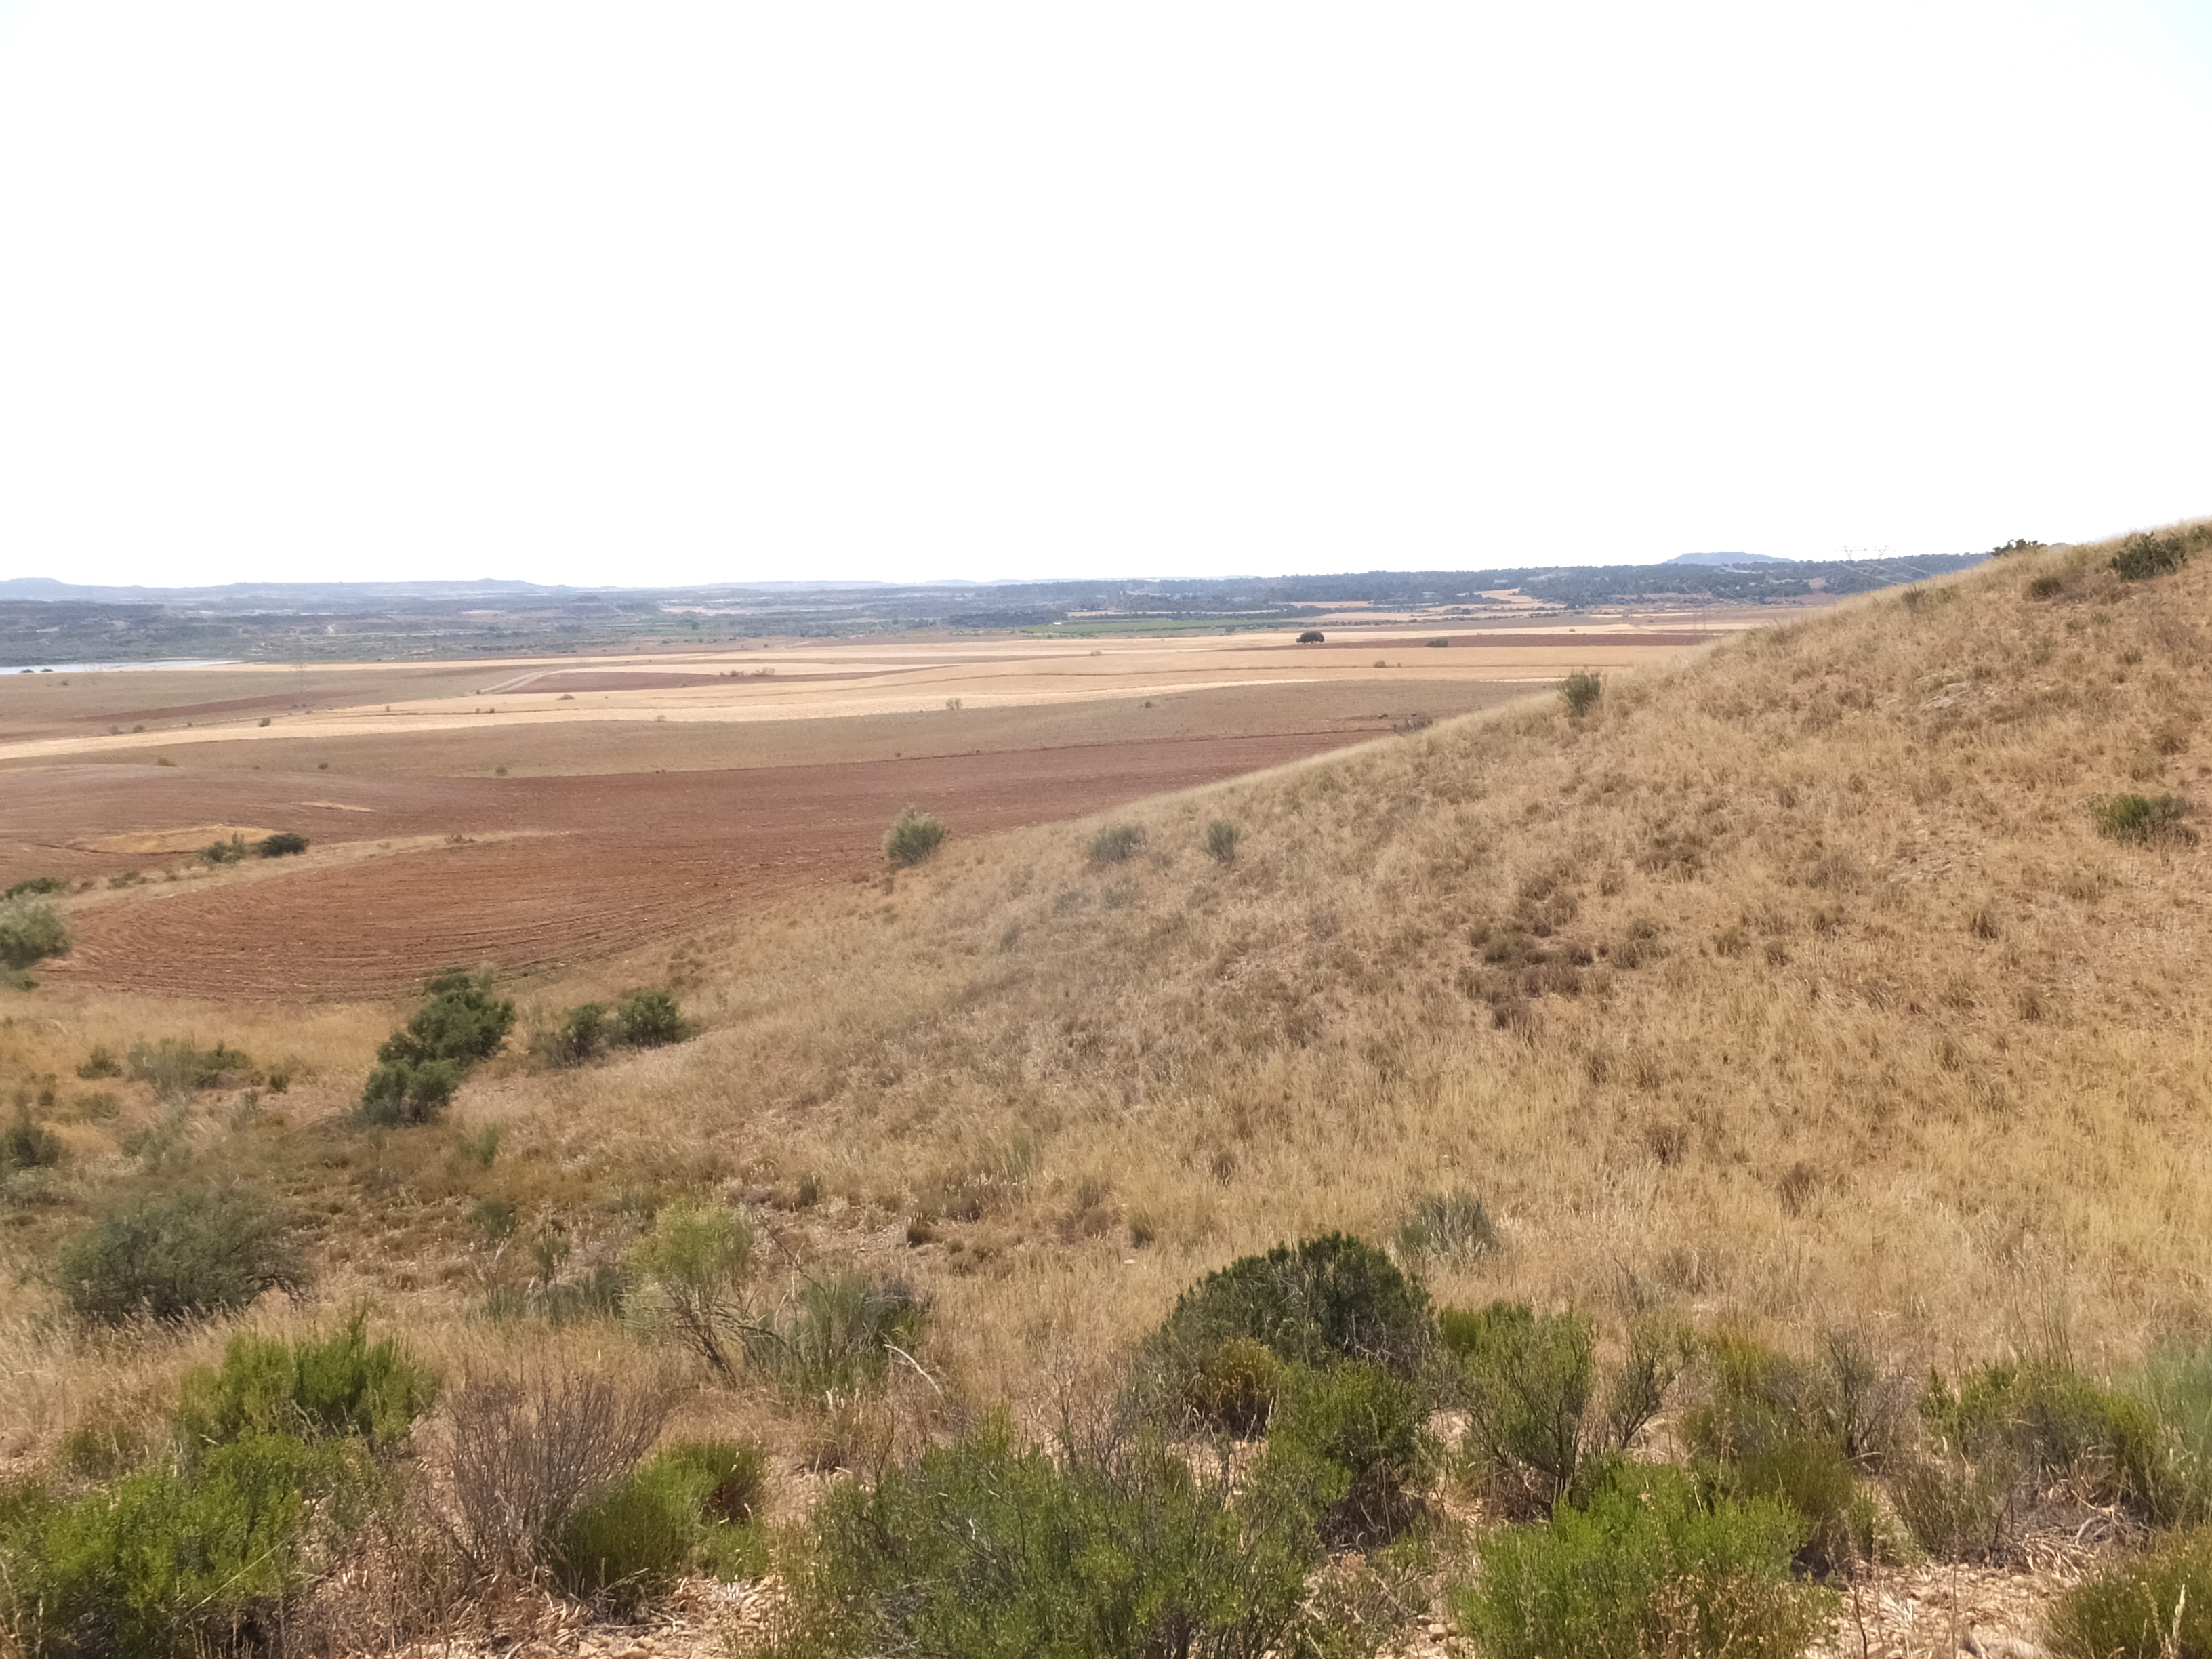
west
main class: Shrubland
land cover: Shrubland with sparse tree cover
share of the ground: 50 - 75 %
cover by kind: shrubs 50 %, herbaceous plants 25 %, consolidated bare surface 20 %, coniferous forest trees 5 %
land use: Semi-natural and natural areas not in use
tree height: < 5 m
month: June
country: ES
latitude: 41.2494
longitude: -0.1688
